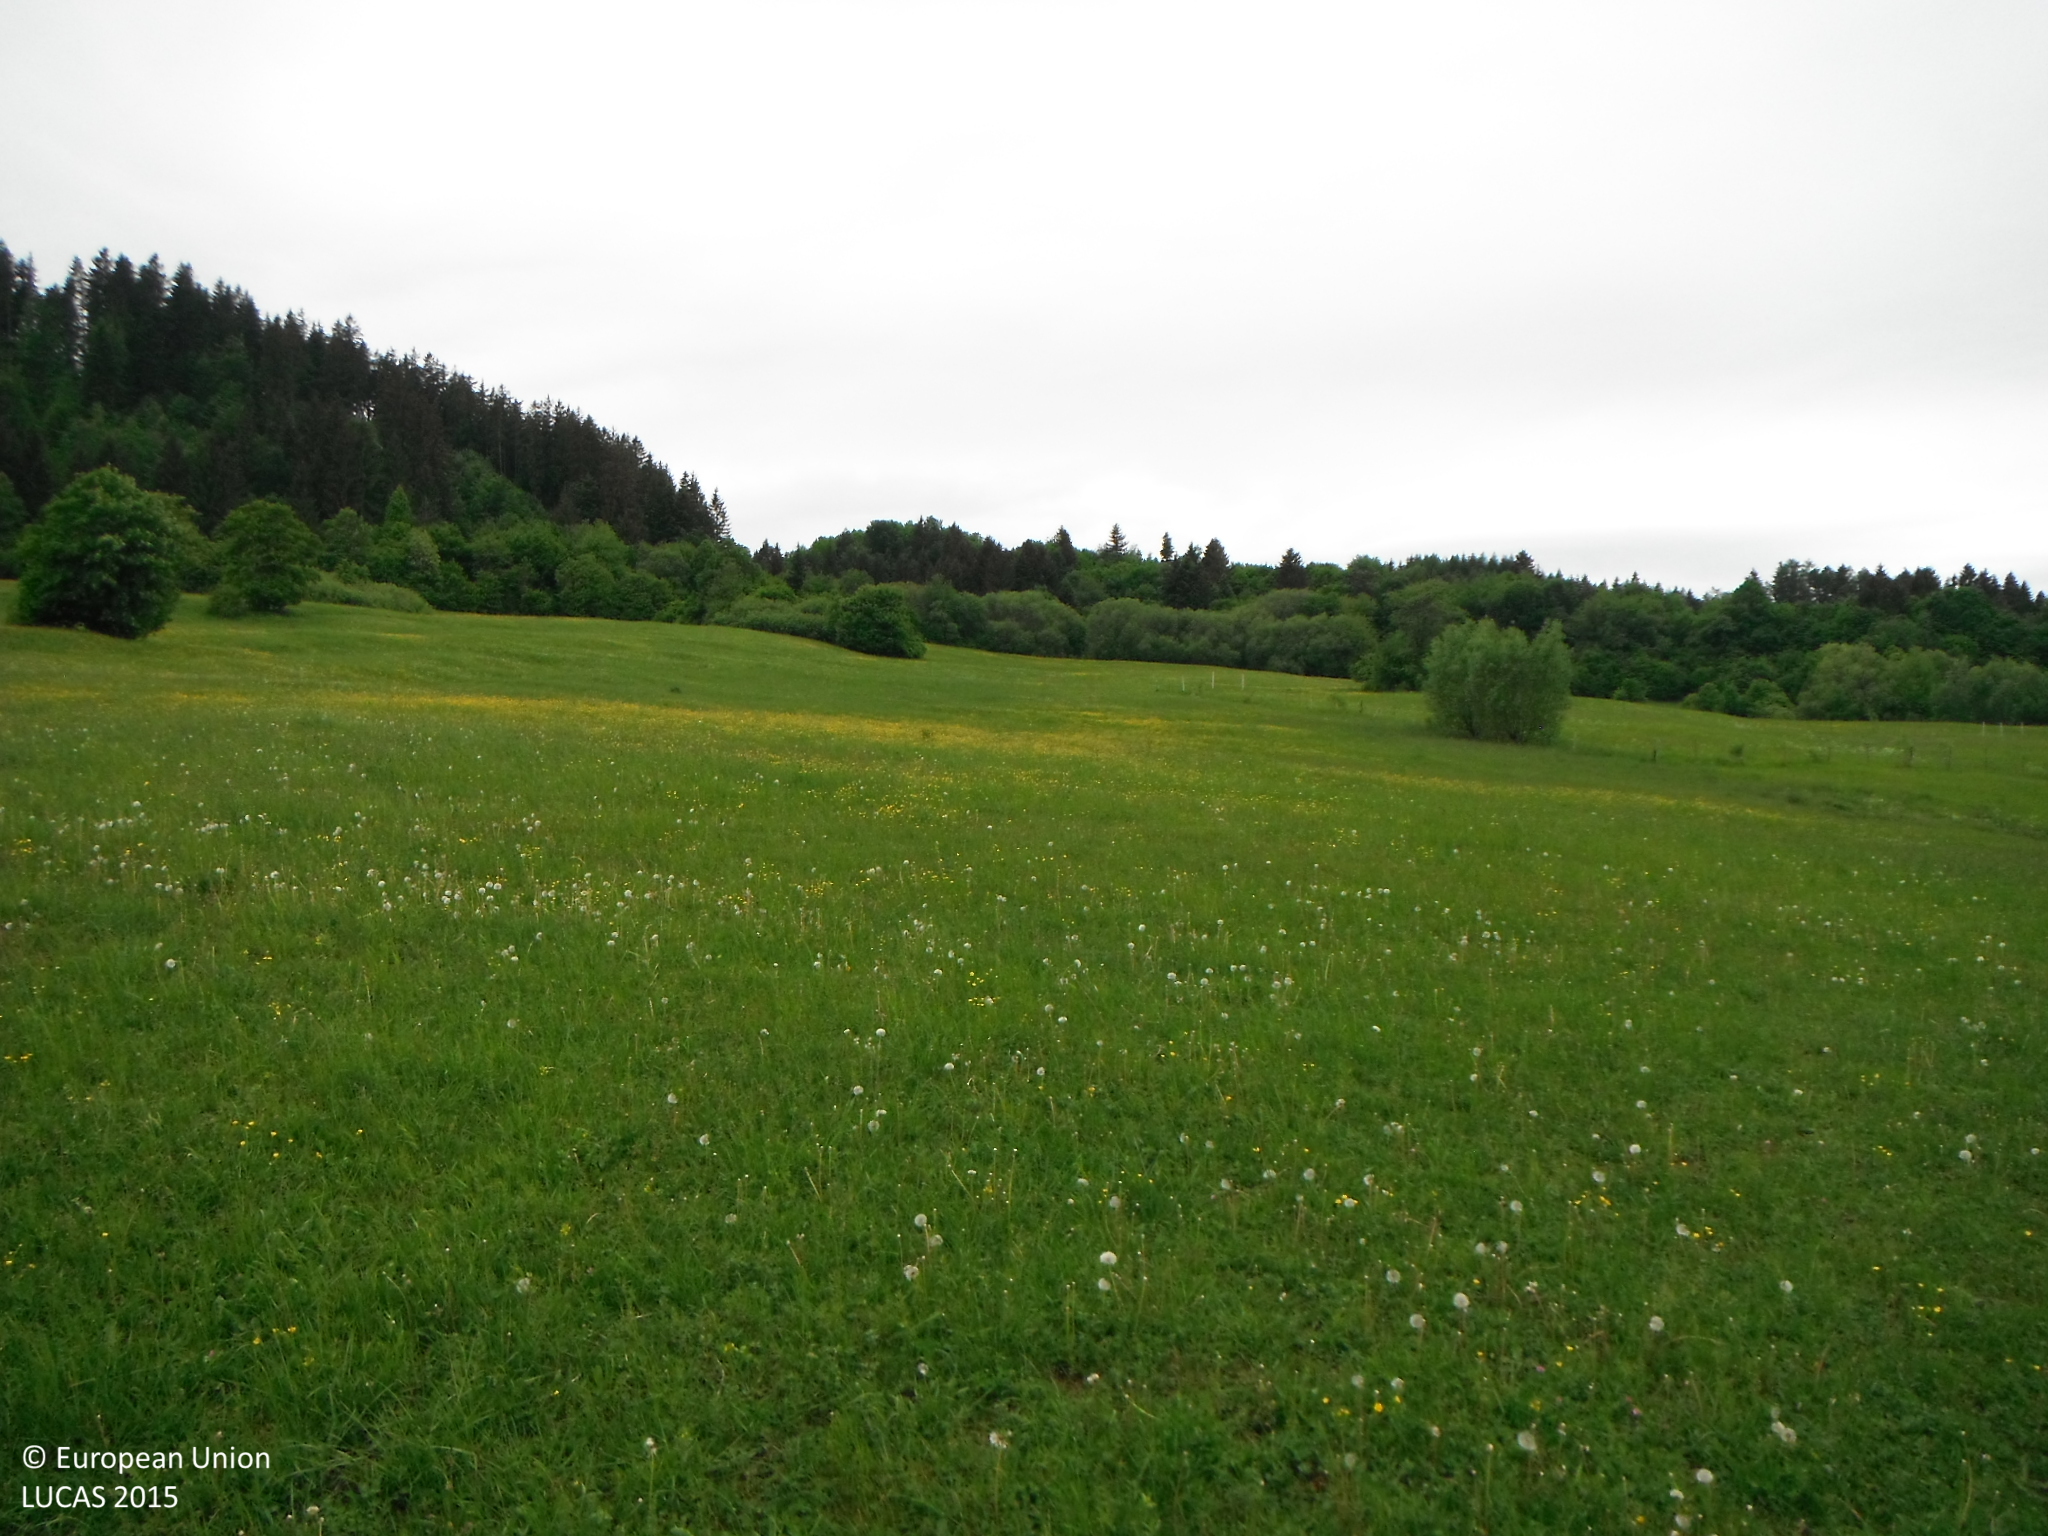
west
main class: Grassland
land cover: Grassland without tree/shrub cover
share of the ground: > 75 %
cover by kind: herbaceous plants 100 %
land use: Agriculture (excluding fallow land and kitchen gardens)
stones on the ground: < 10 %
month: May
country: SK
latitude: 48.7344
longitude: 19.0908
